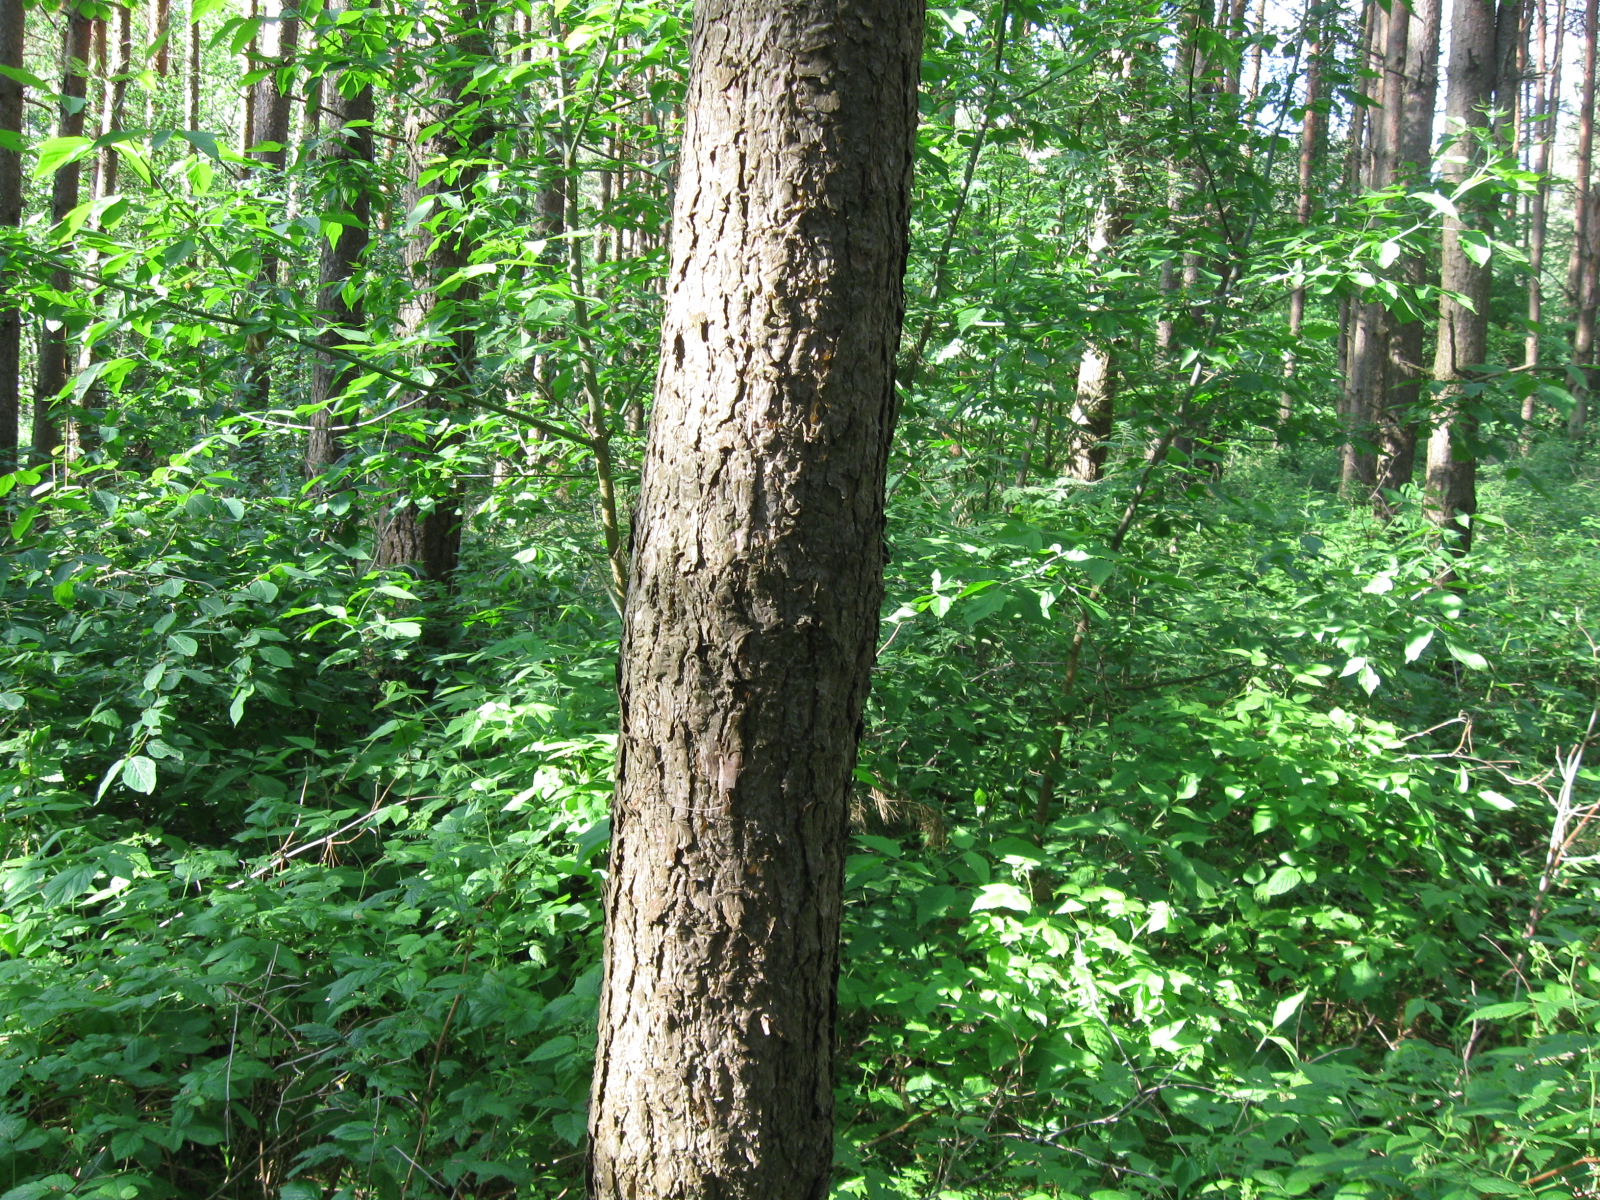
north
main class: Woodland
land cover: Pine dominated coniferous woodland
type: hemiboreal forest and nemoral coniferous forest and mixed broadleaved-coniferous forest
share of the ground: > 75 %
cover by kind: coniferous forest trees 90 %, broadleaved forest trees 5 %, herbaceous plants 5 %
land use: Forestry
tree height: > 5 m
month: June
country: LT
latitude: 54.2750
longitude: 23.7396
